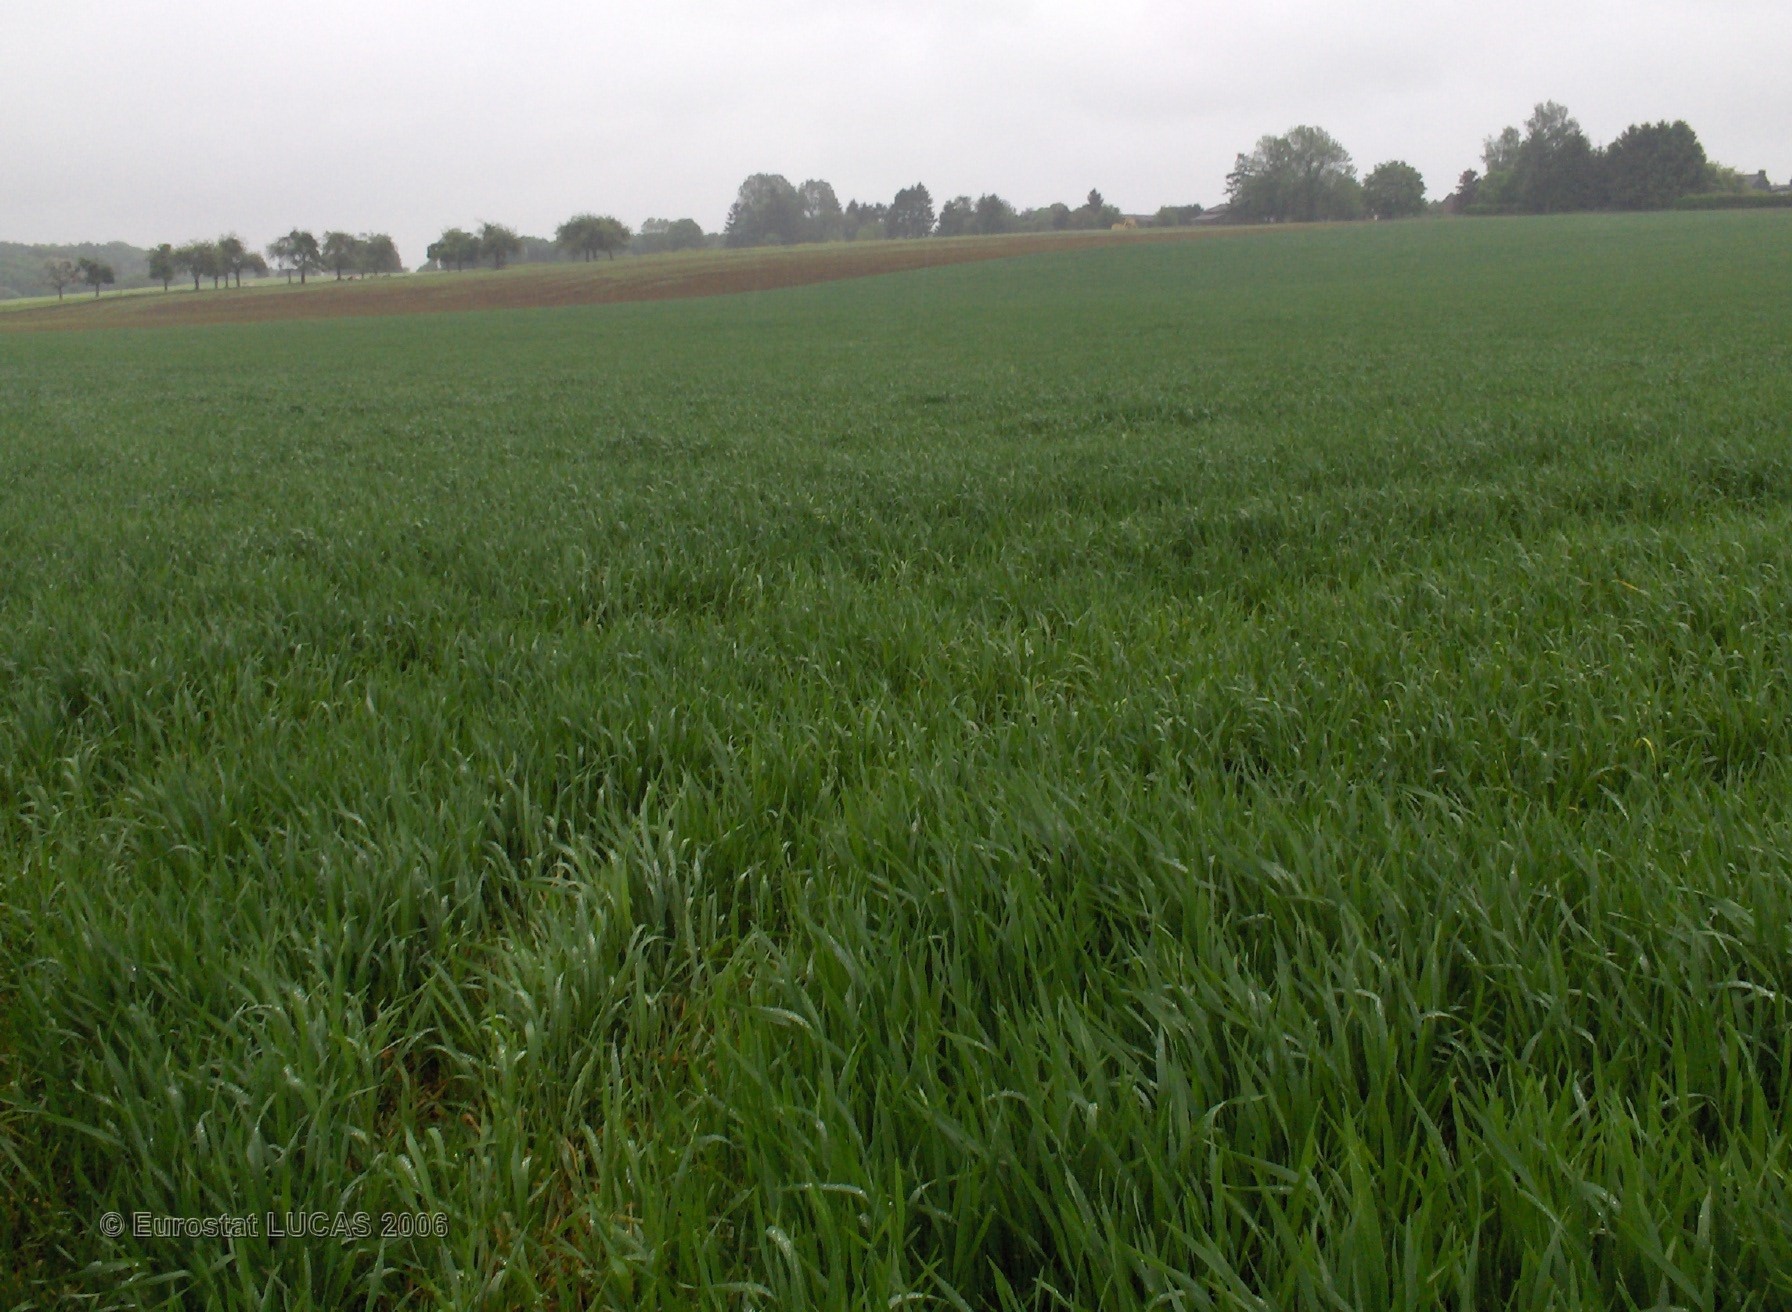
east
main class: Cropland
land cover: Common wheat
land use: Agriculture (excluding fallow land and kitchen gardens)
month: May
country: BE
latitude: 50.3548
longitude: 5.2330
